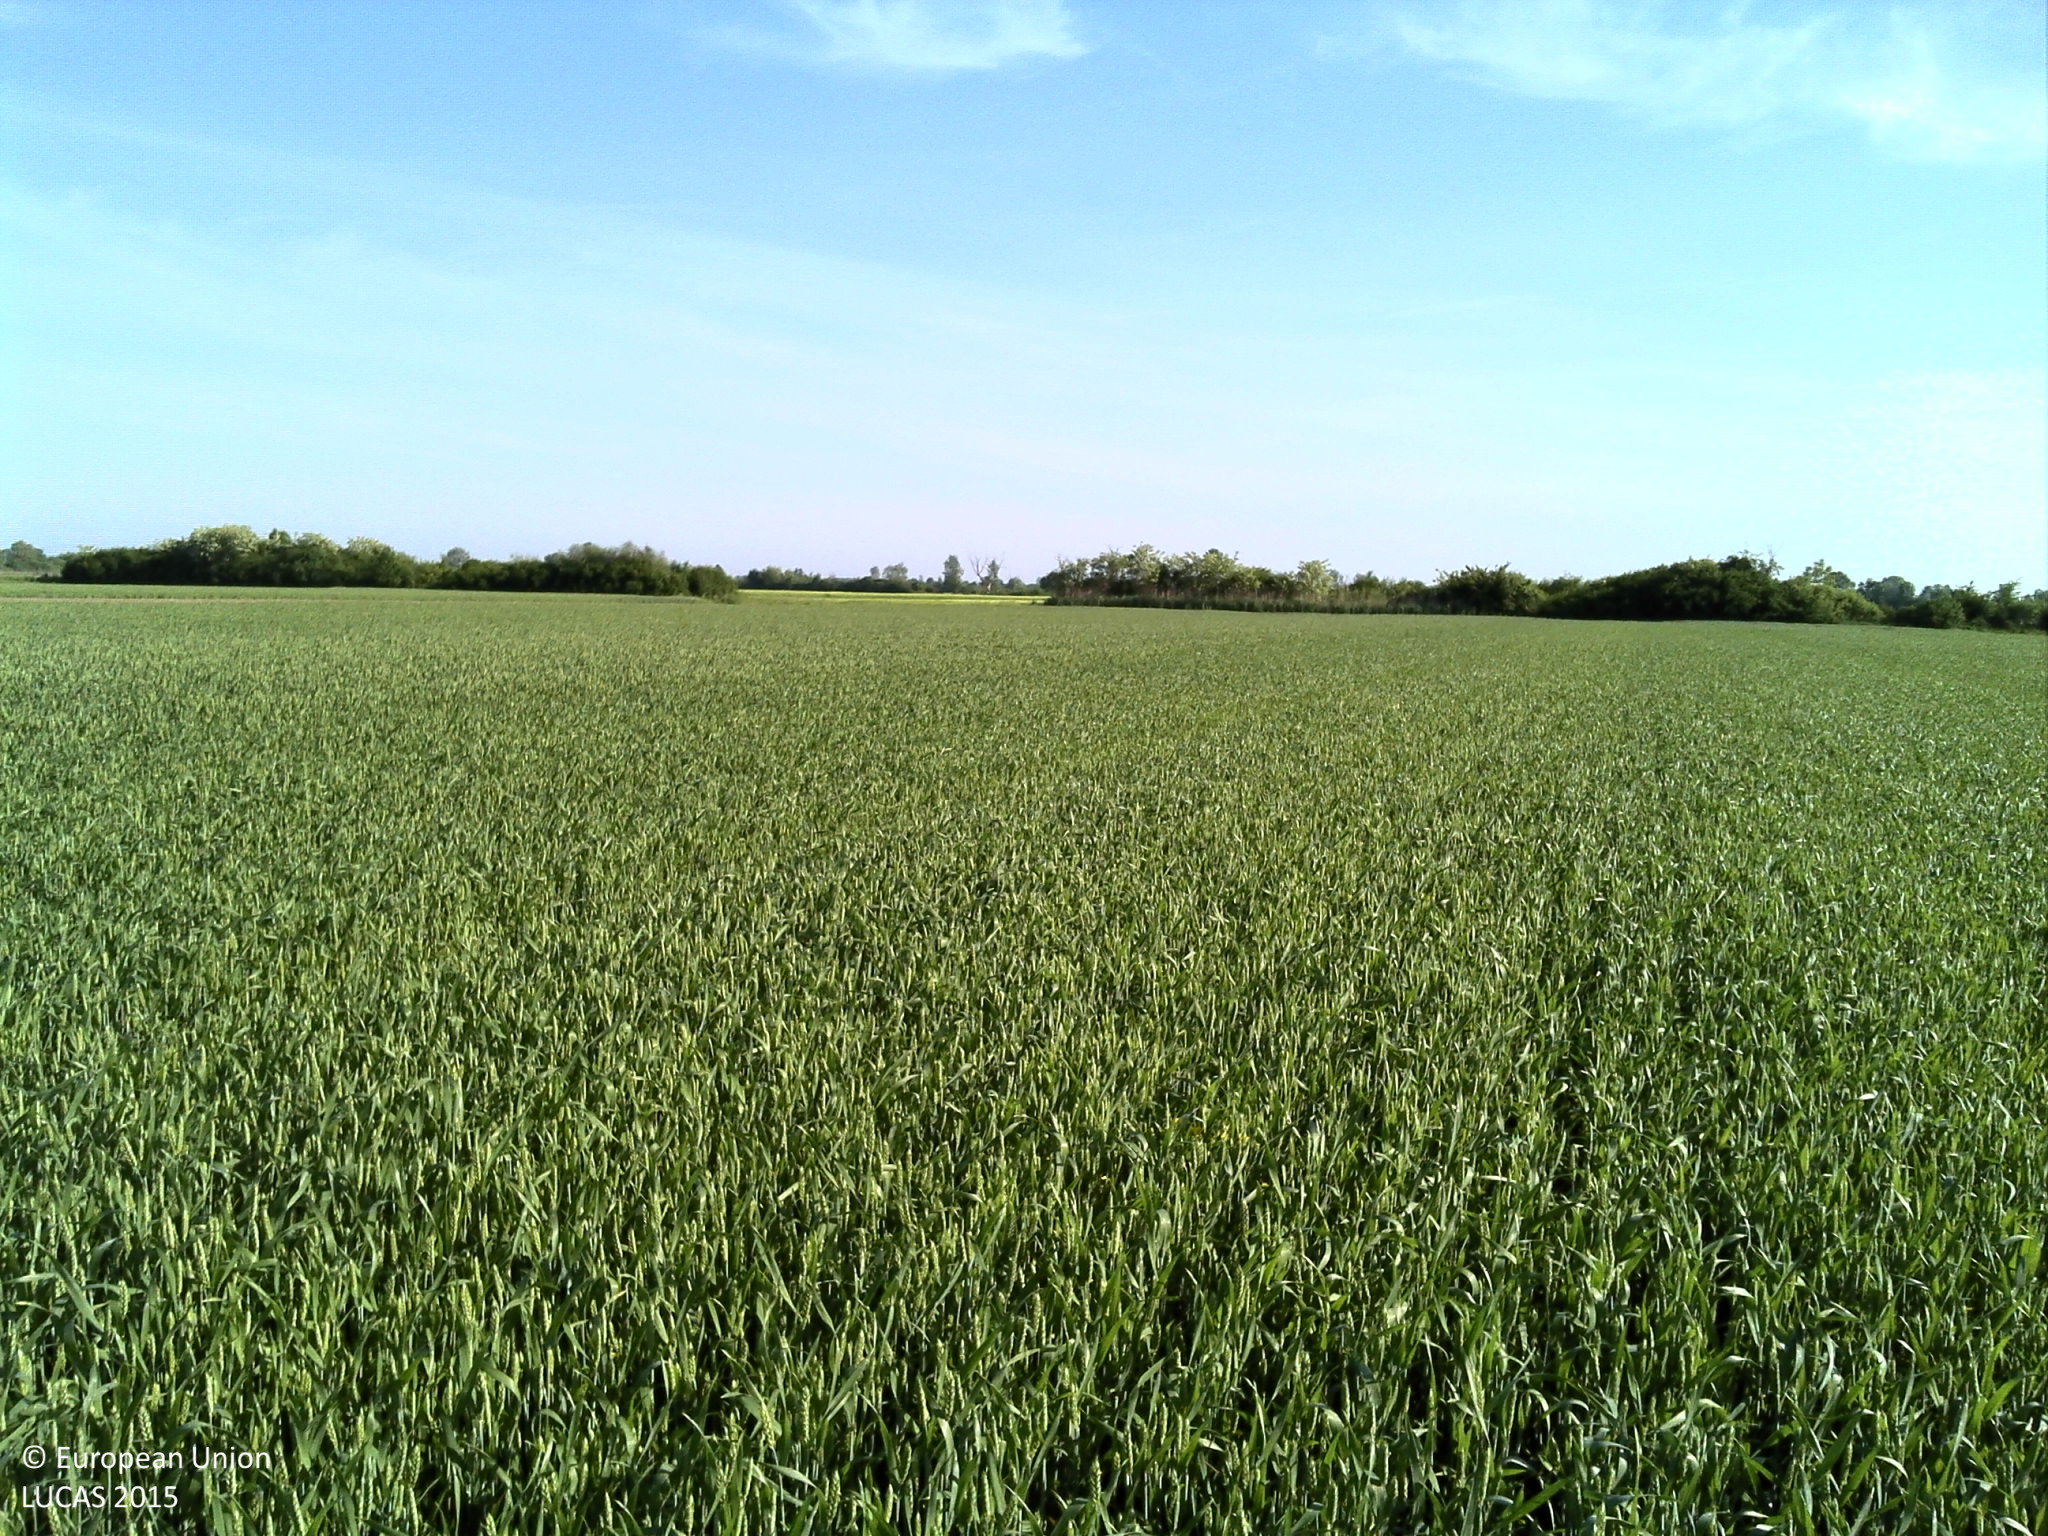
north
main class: Cropland
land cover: Common wheat
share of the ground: > 75 %
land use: Agriculture (excluding fallow land and kitchen gardens)
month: May
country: HR
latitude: 45.4705
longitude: 18.2551
